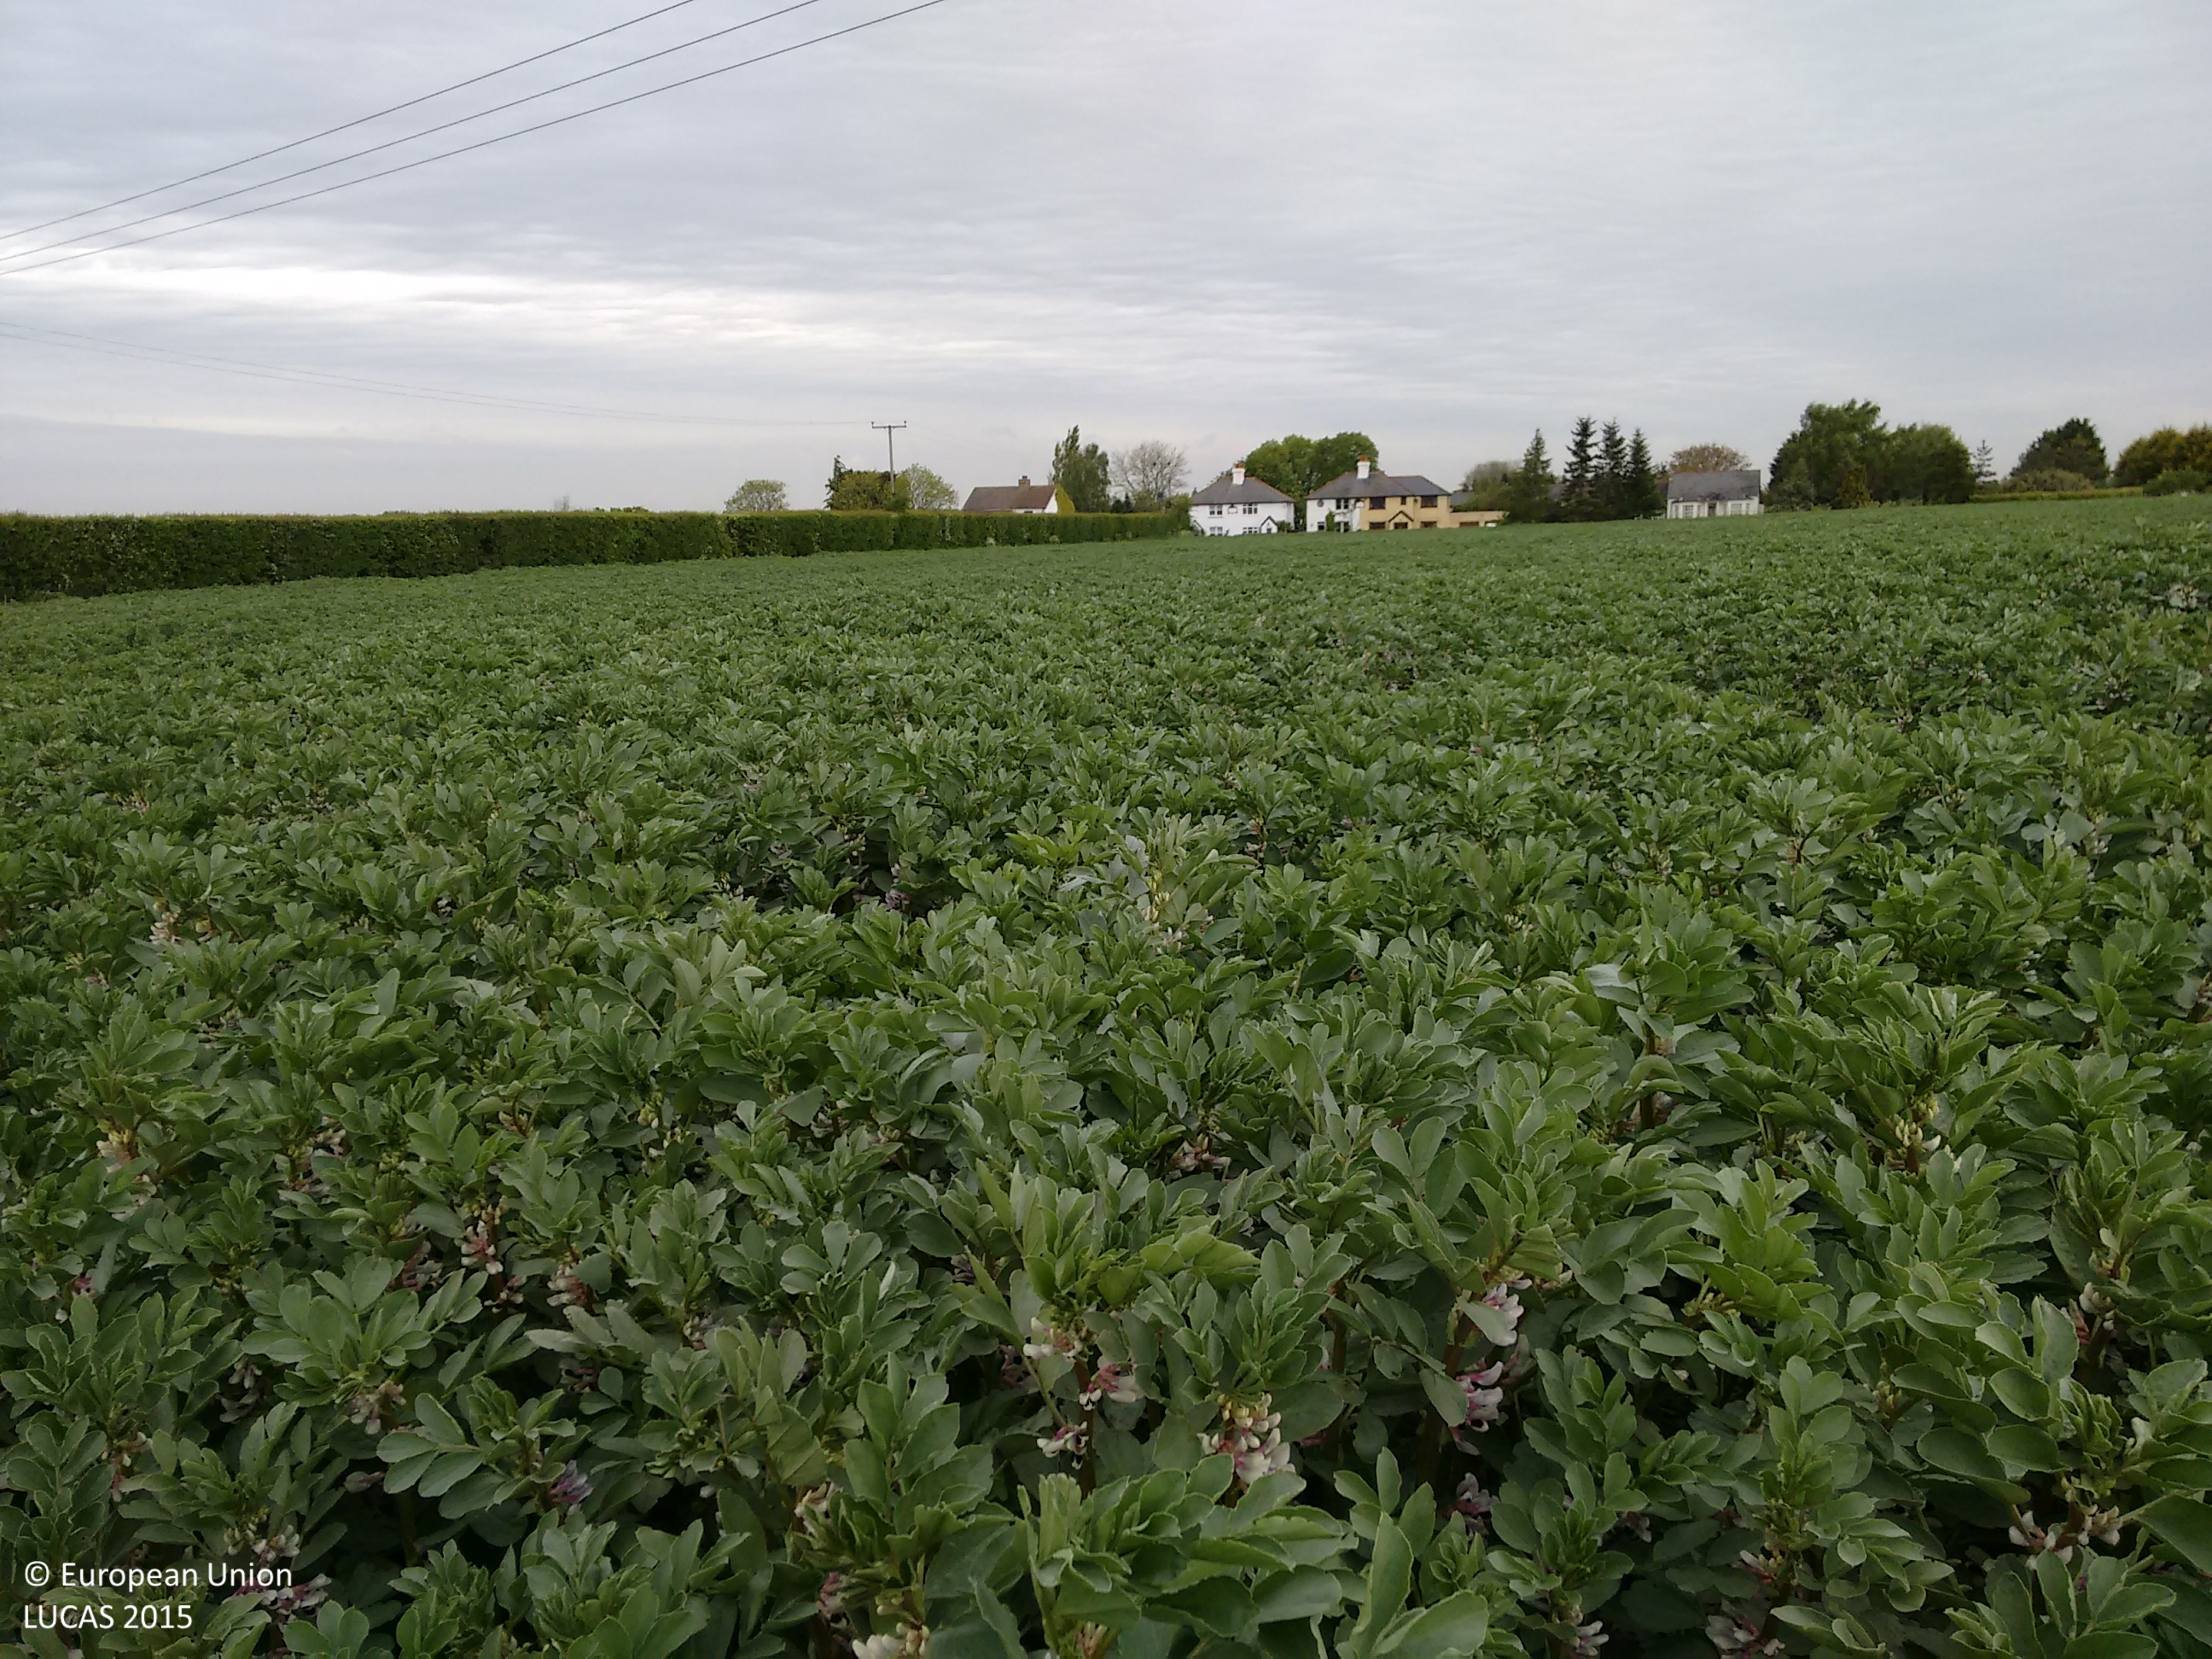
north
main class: Cropland
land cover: Dry pulses
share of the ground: > 75 %
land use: Agriculture (excluding fallow land and kitchen gardens)
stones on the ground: 10 - 25 %
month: May
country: GB
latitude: 51.3972
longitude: 0.2680
